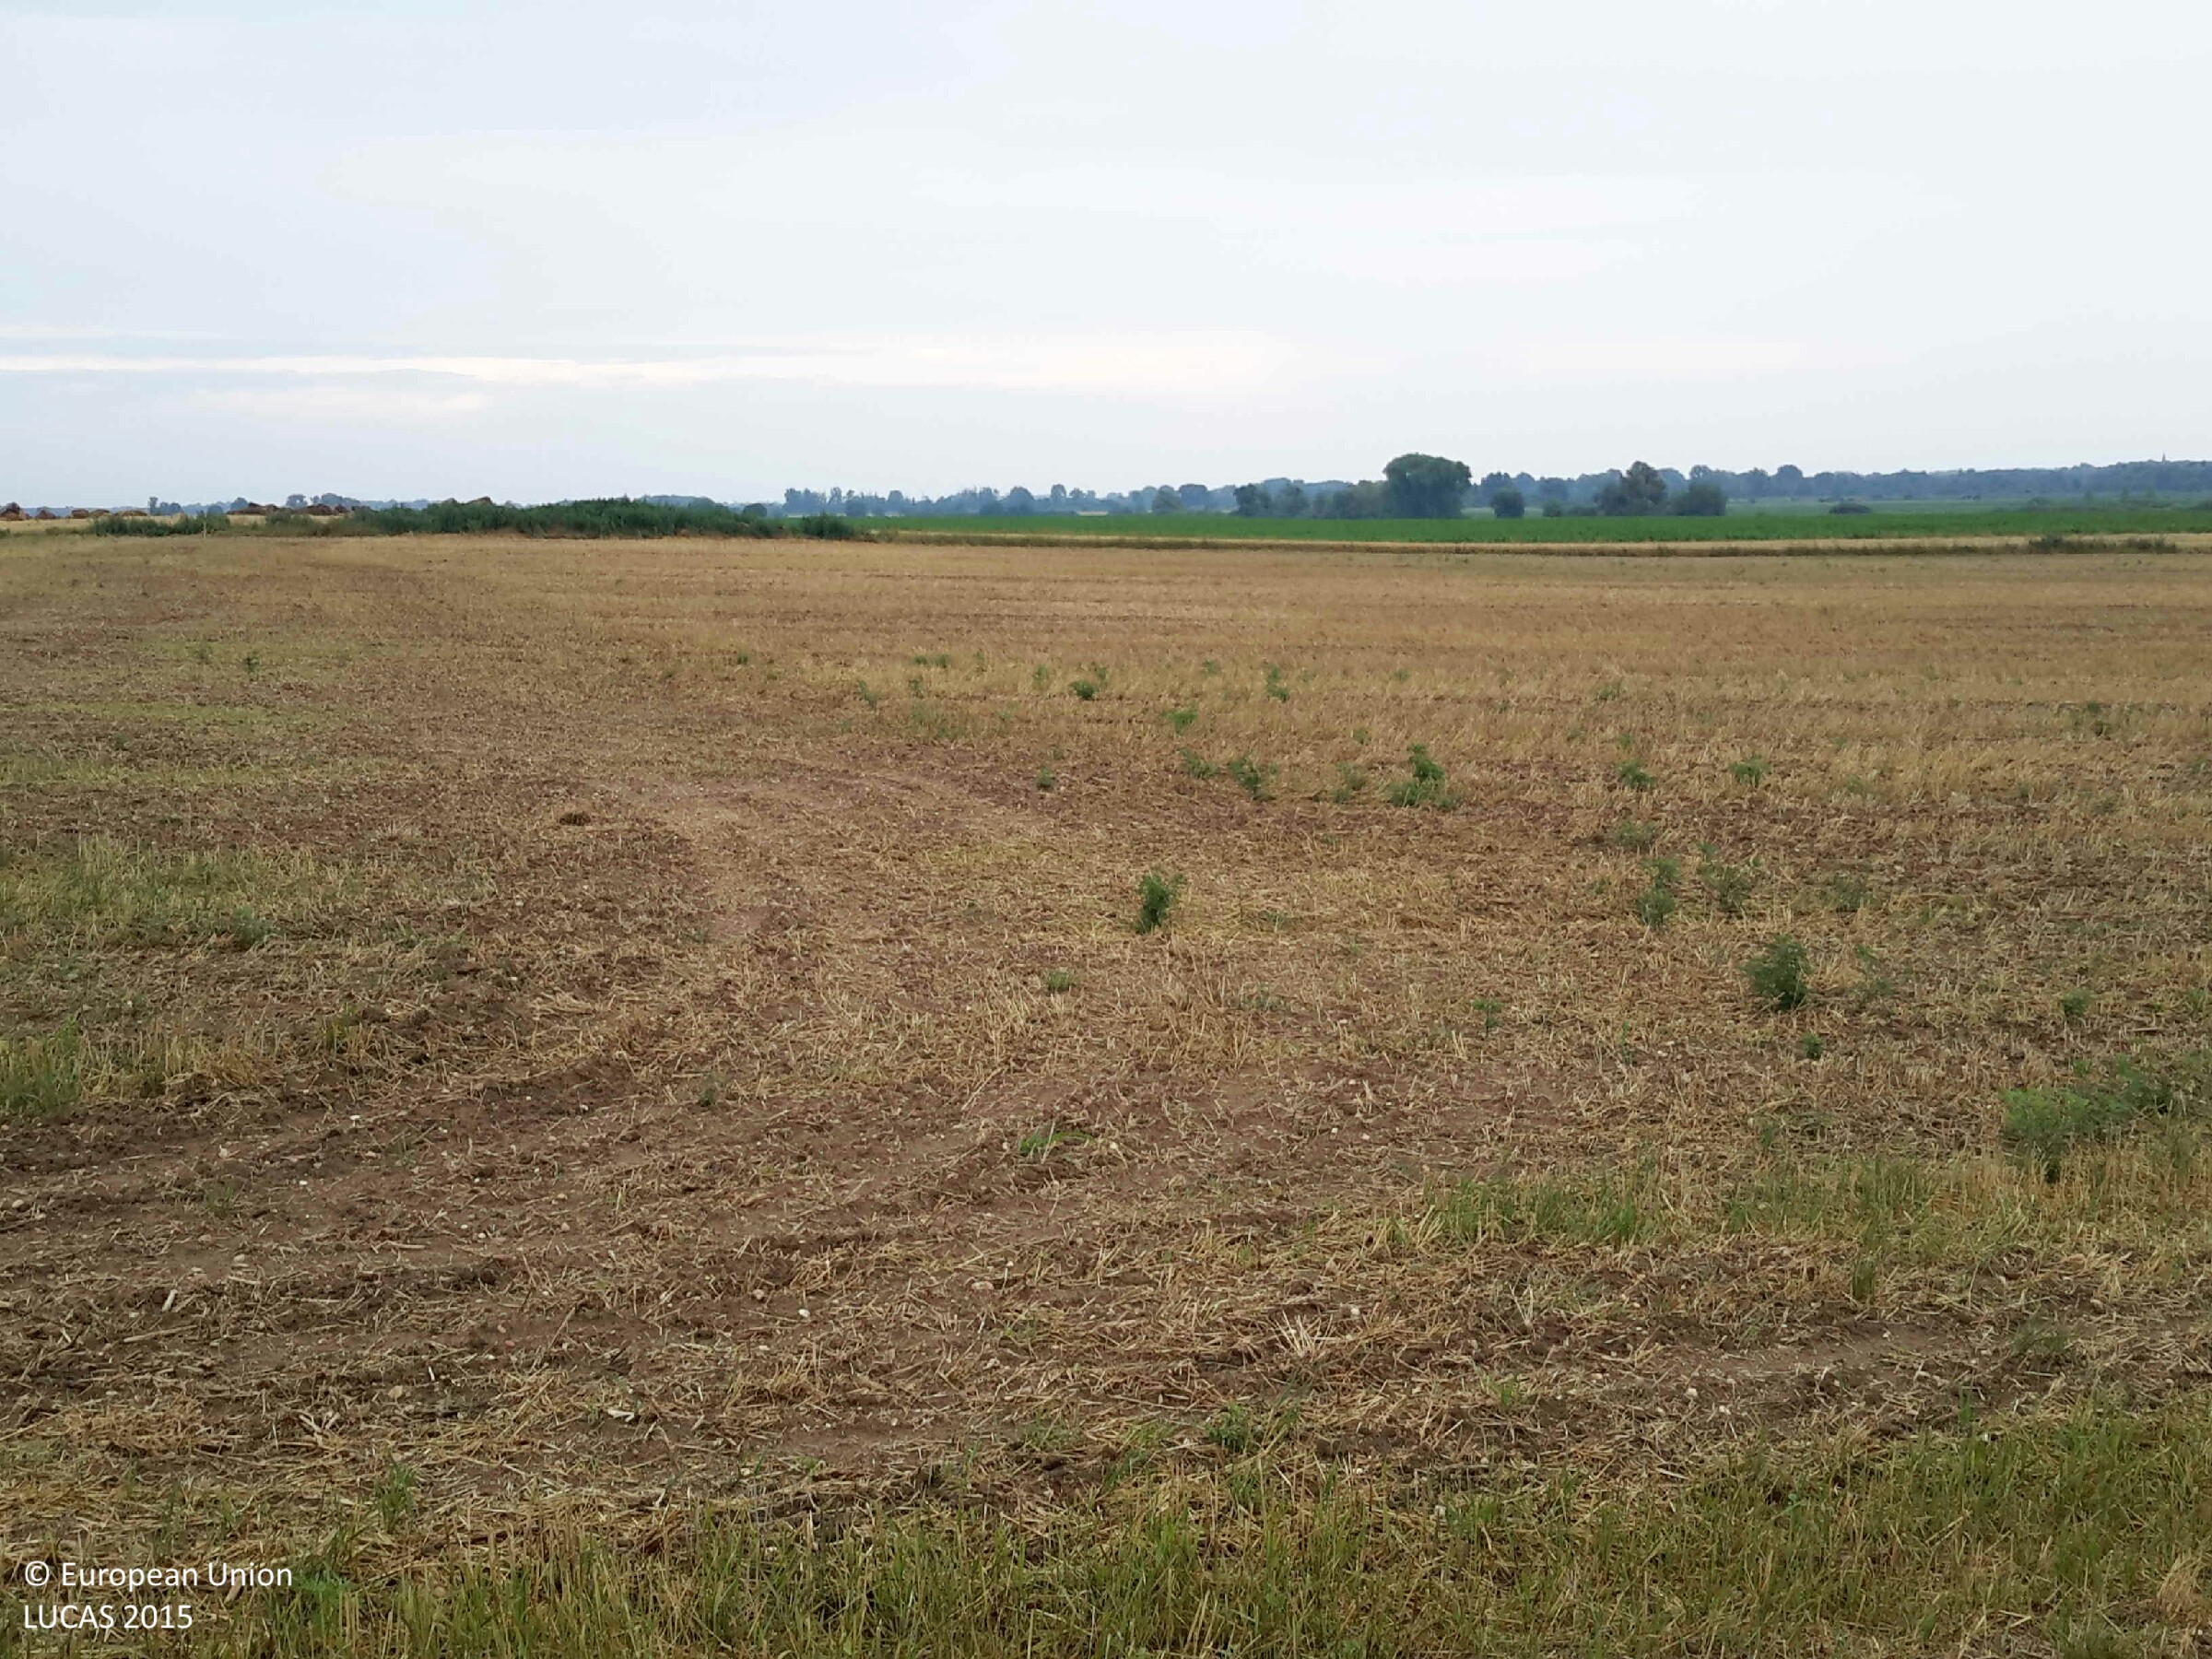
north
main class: Cropland
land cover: Common wheat
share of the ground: > 75 %
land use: Agriculture (excluding fallow land and kitchen gardens)
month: July
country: HU
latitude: 47.1214
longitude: 17.1891
